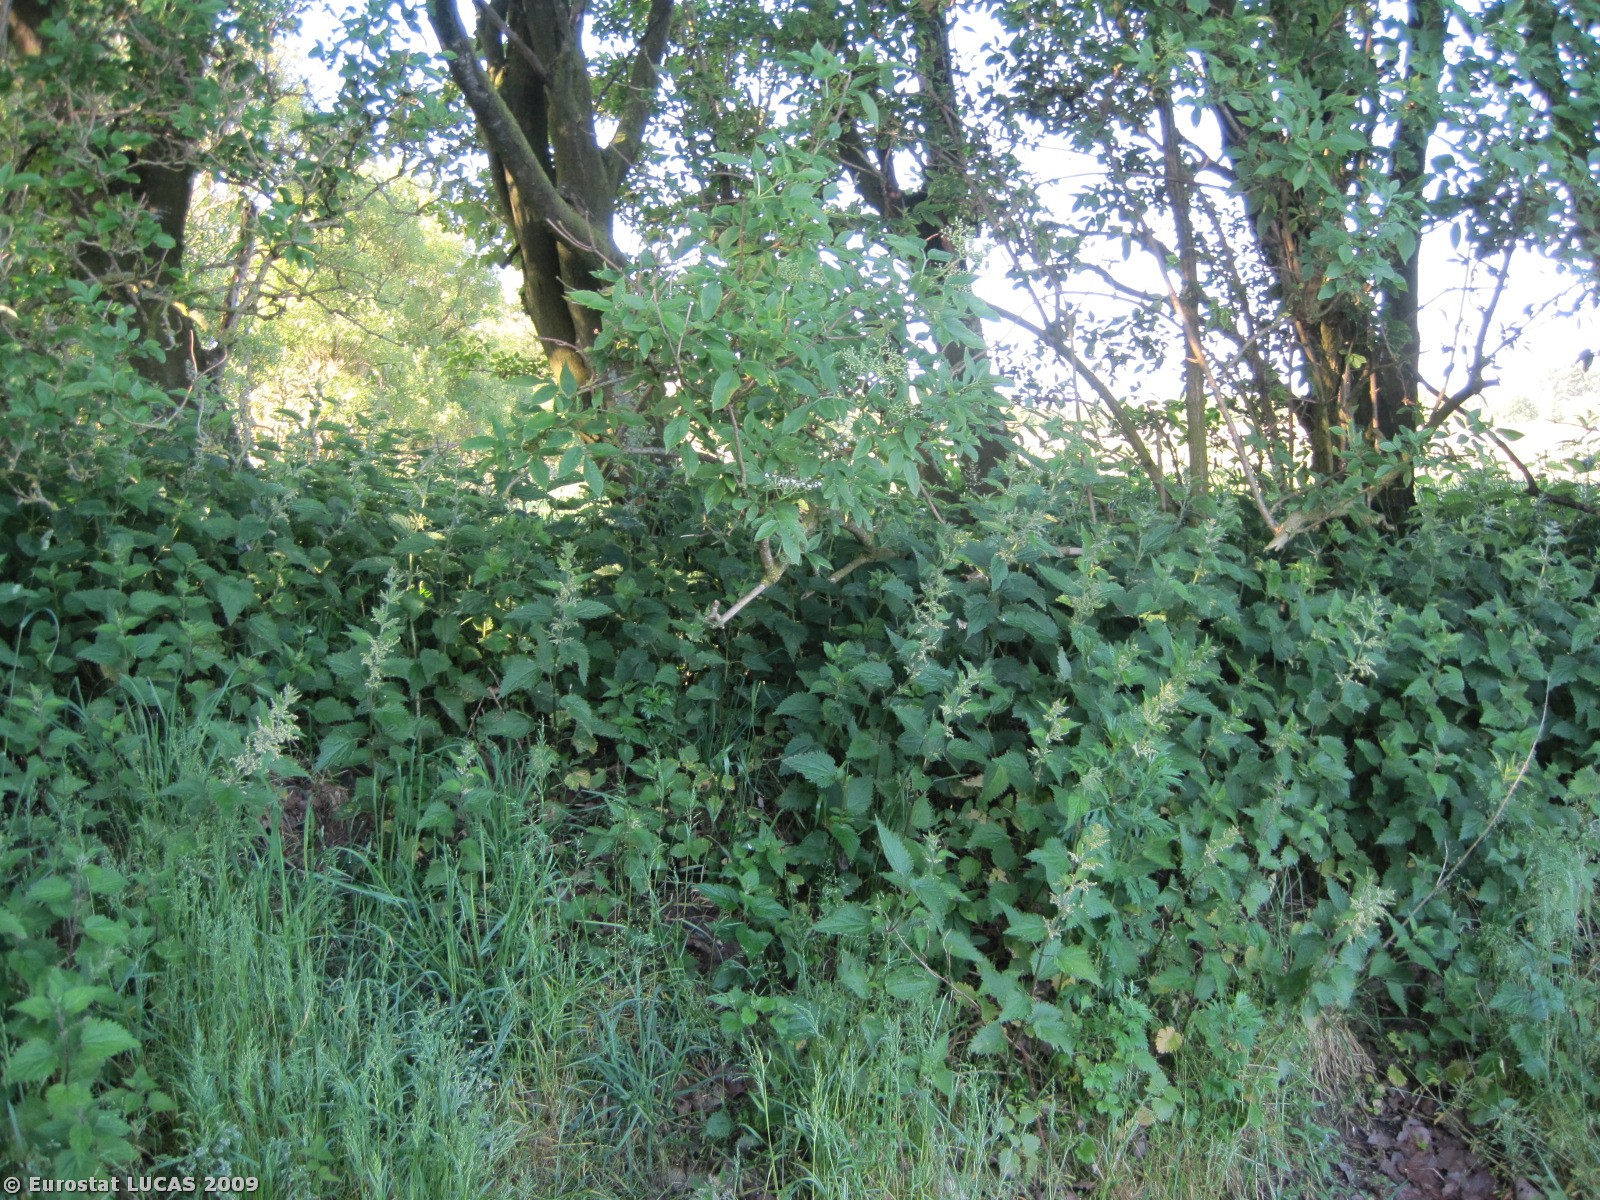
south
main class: Woodland
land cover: Broadleaved woodland
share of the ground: > 75 %
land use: Unused
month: June
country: DK
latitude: 57.1764
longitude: 10.1486
